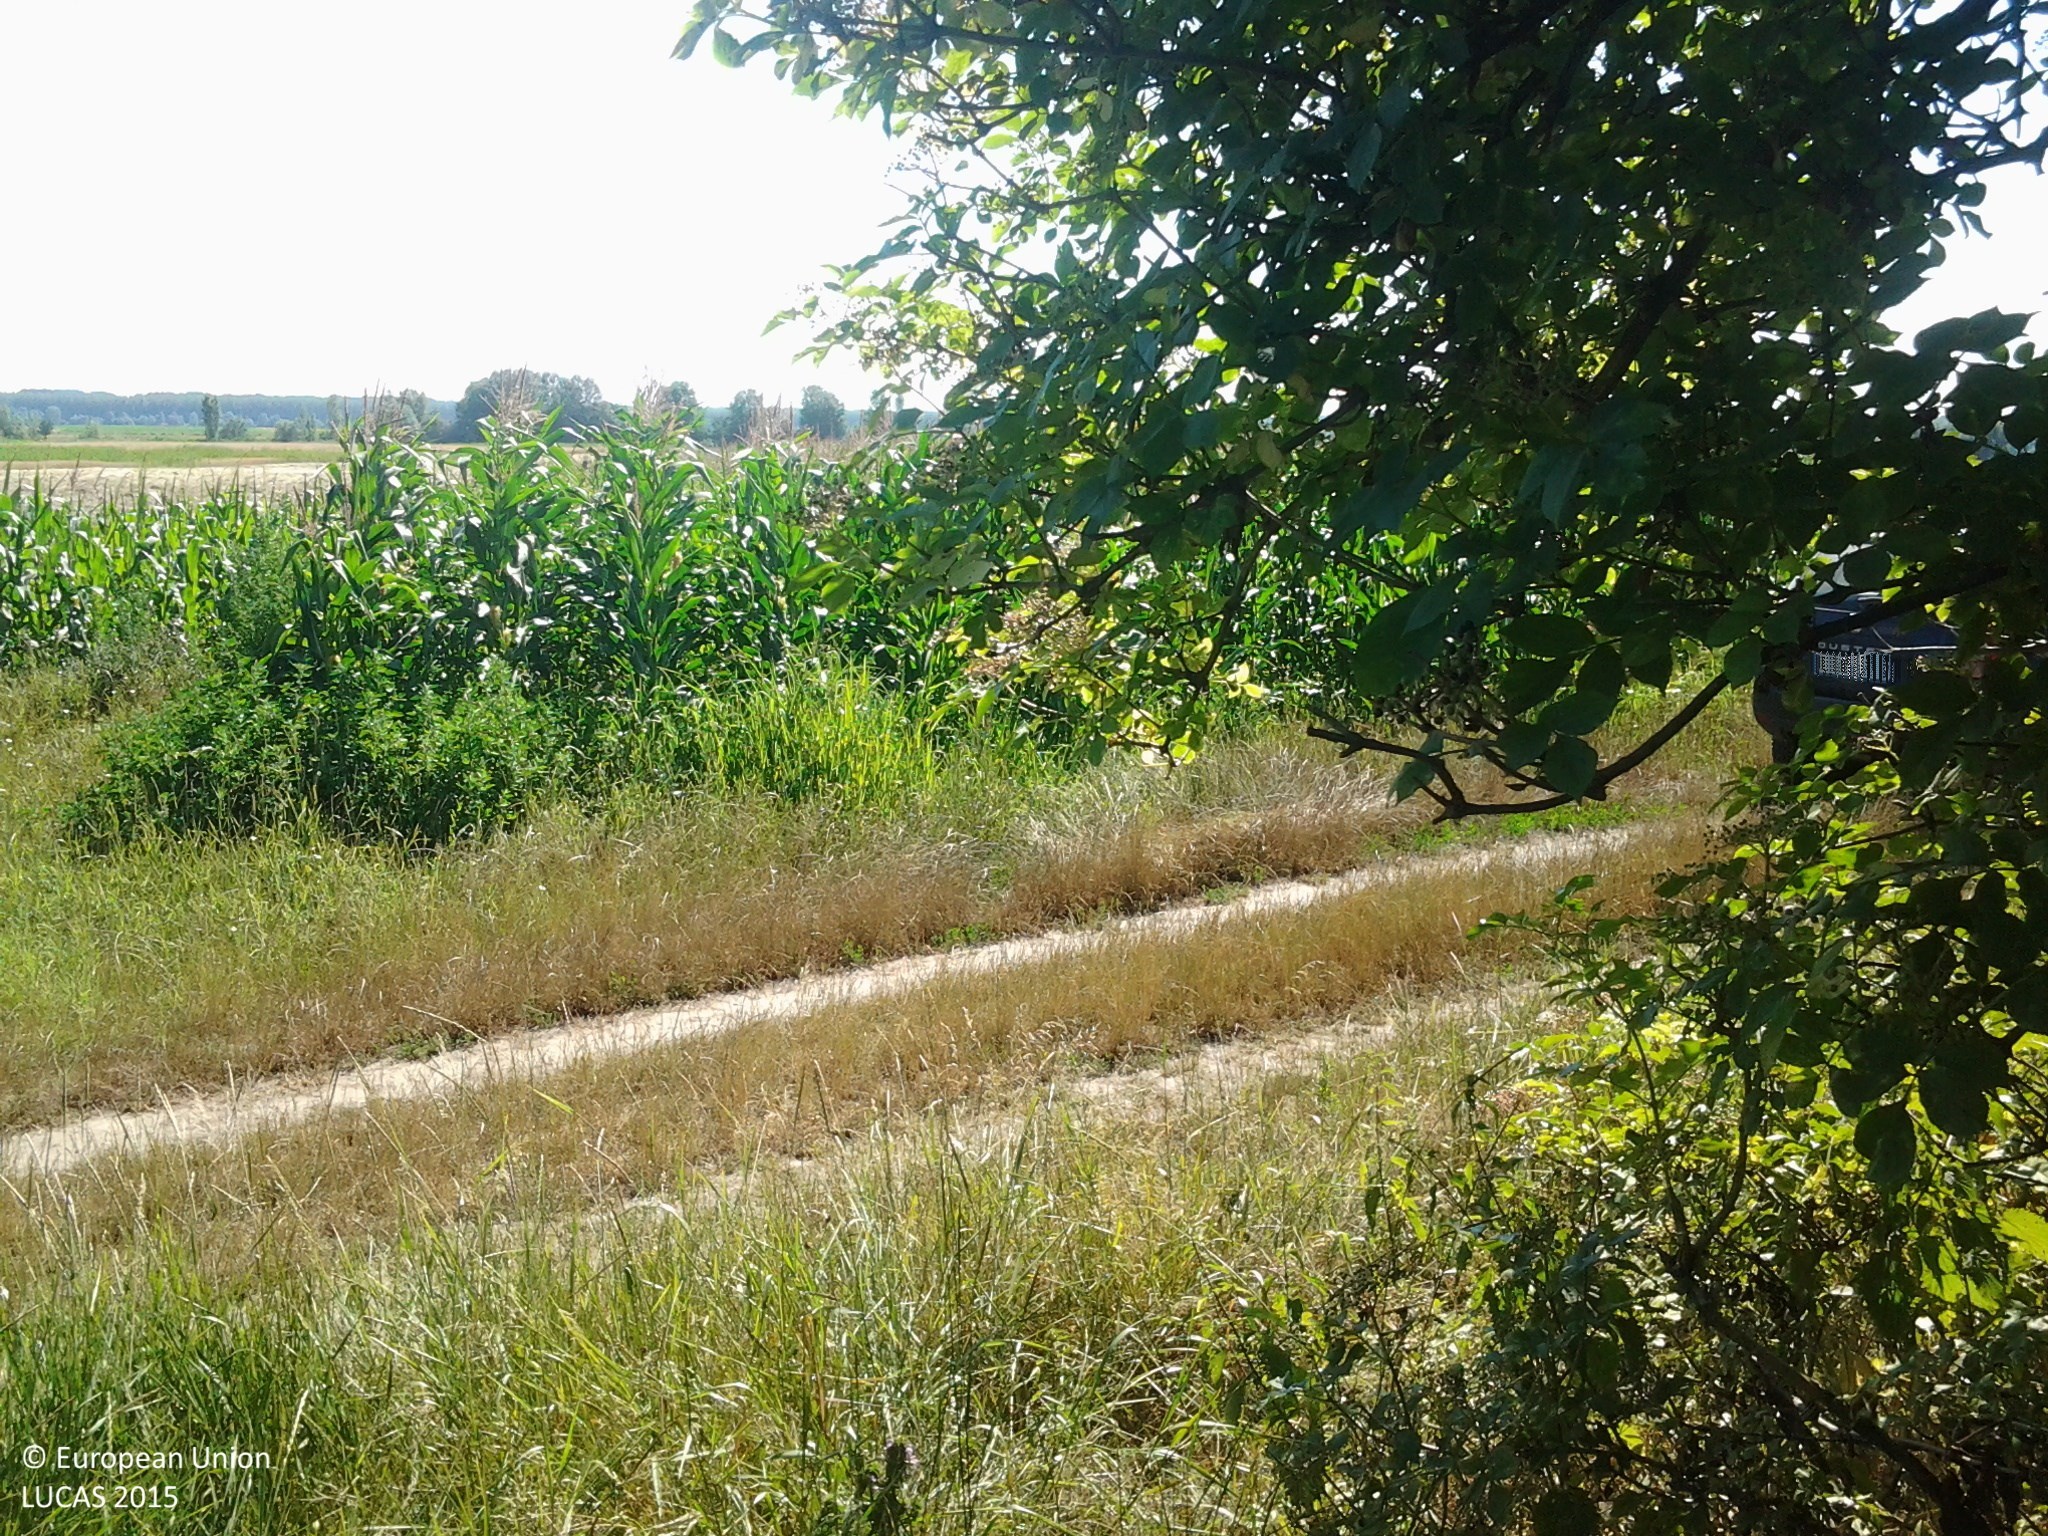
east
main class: Grassland
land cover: Grassland with sparse tree/shrub cover
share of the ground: > 75 %
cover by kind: herbaceous plants 90 %, broadleaved forest trees 5 %, shrubs 5 %
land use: Semi-natural and natural areas not in use
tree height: < 5 m
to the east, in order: Grassland with sparse tree/shrub cover; Tracks; Maize
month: July
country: HU
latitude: 46.9221
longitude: 20.1233
